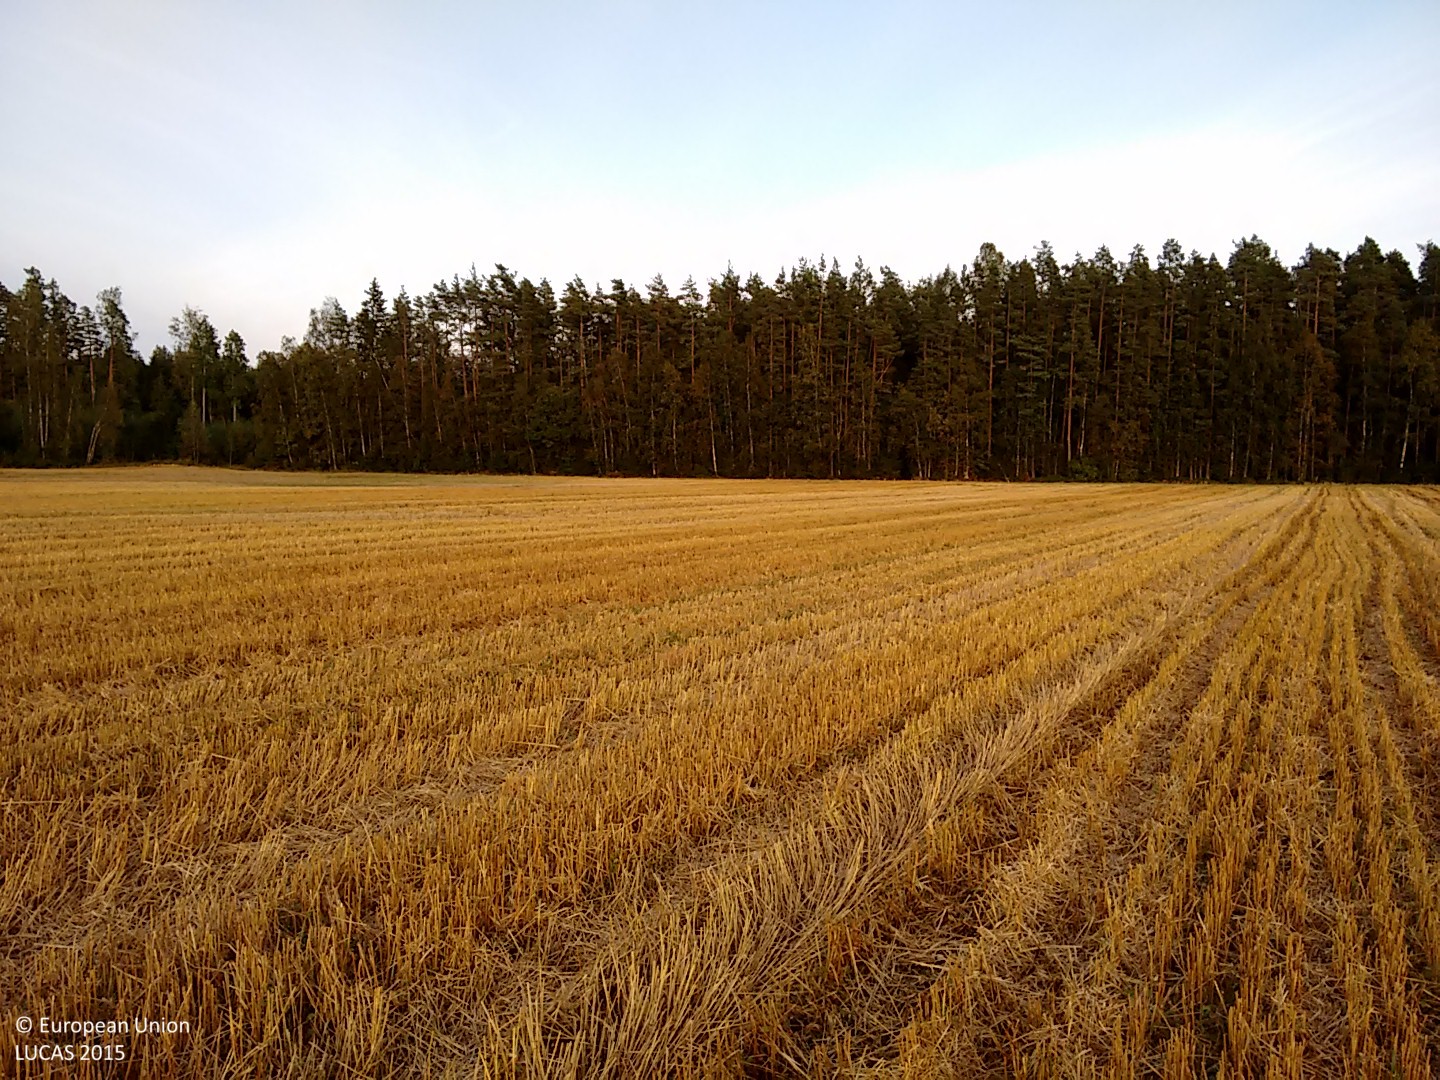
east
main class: Cropland
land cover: Barley
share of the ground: > 75 %
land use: Agriculture (excluding fallow land and kitchen gardens)
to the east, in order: Barley; Shruby margins; Ditches and canals; Broadleaved woodland; Spruce dominated mixed woodland; Broadleaved woodland; Ditches and canals; Broadleaved woodland
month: September
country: FI
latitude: 60.8693
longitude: 22.0125
